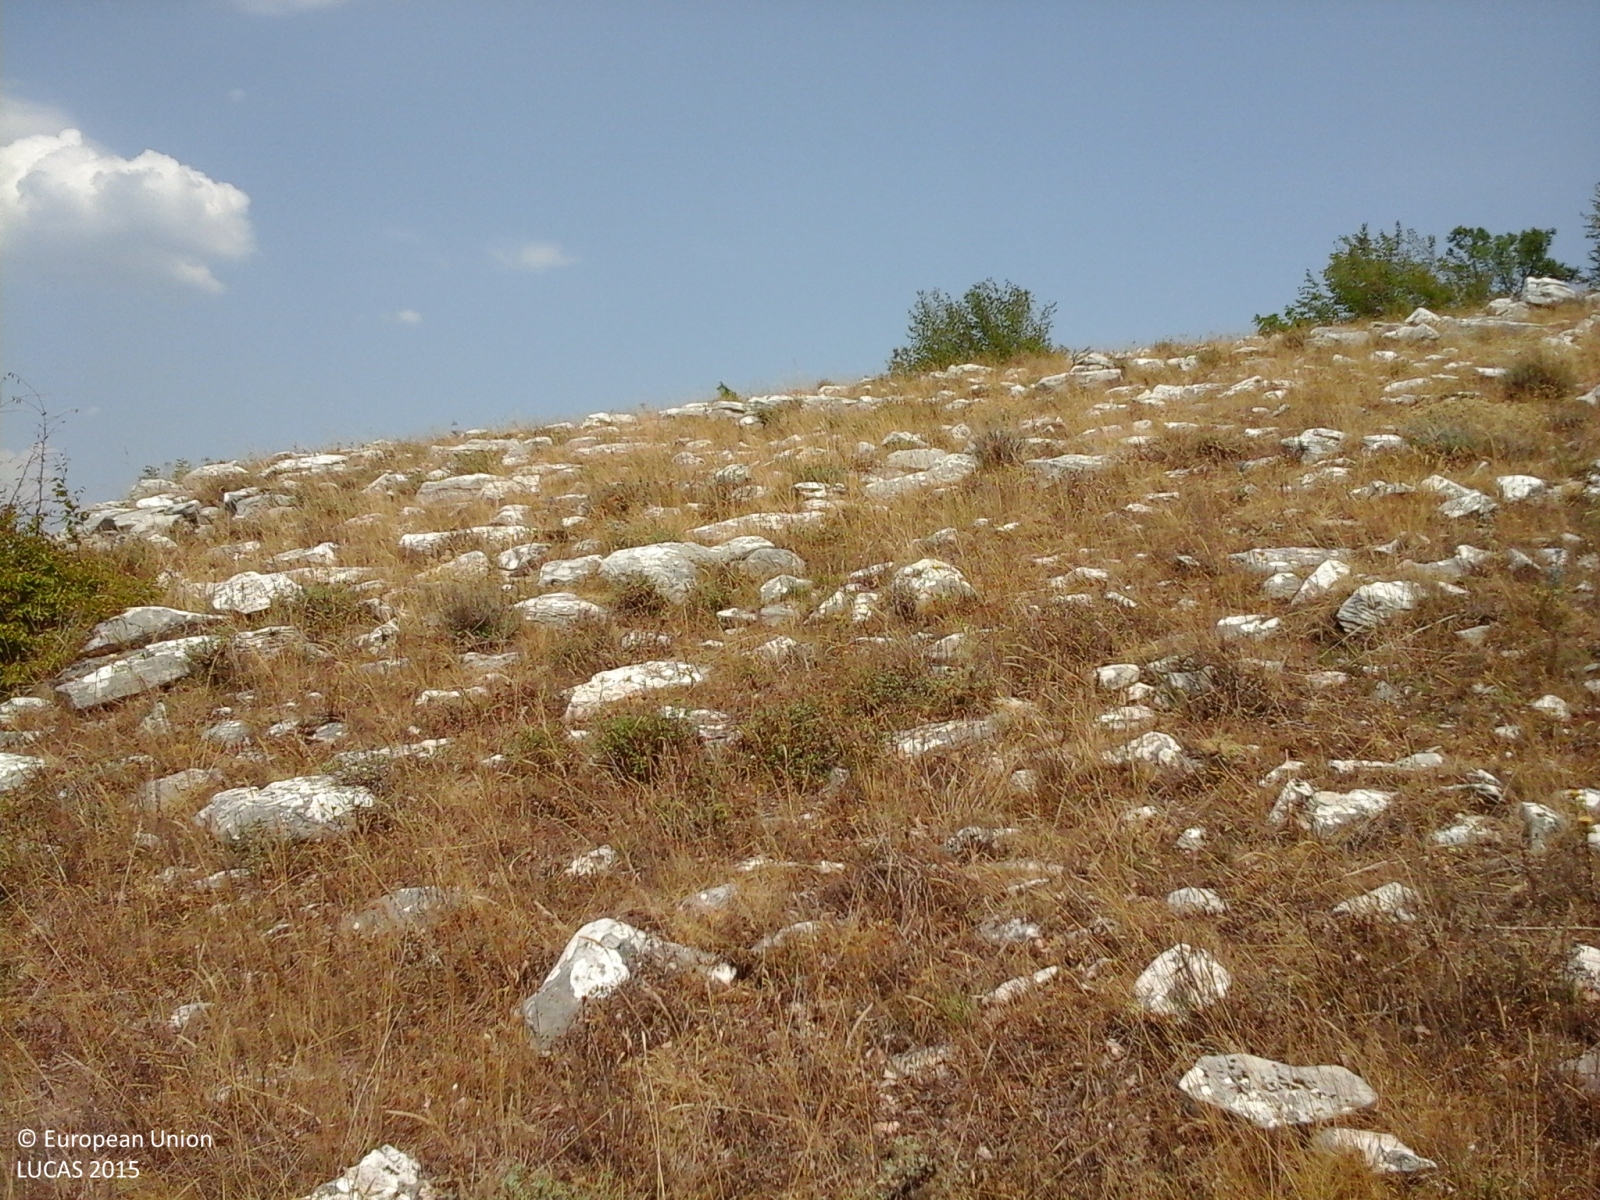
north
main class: Woodland
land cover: Broadleaved woodland
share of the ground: > 75 %
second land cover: Grassland without tree/shrub cover
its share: > 75 %
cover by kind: broadleaved forest trees 85 %, shrubs 10 %, herbaceous plants 5 %
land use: Forestry
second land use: Agriculture (excluding fallow land and kitchen gardens)
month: August
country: IT
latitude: 41.5000
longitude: 14.1894
